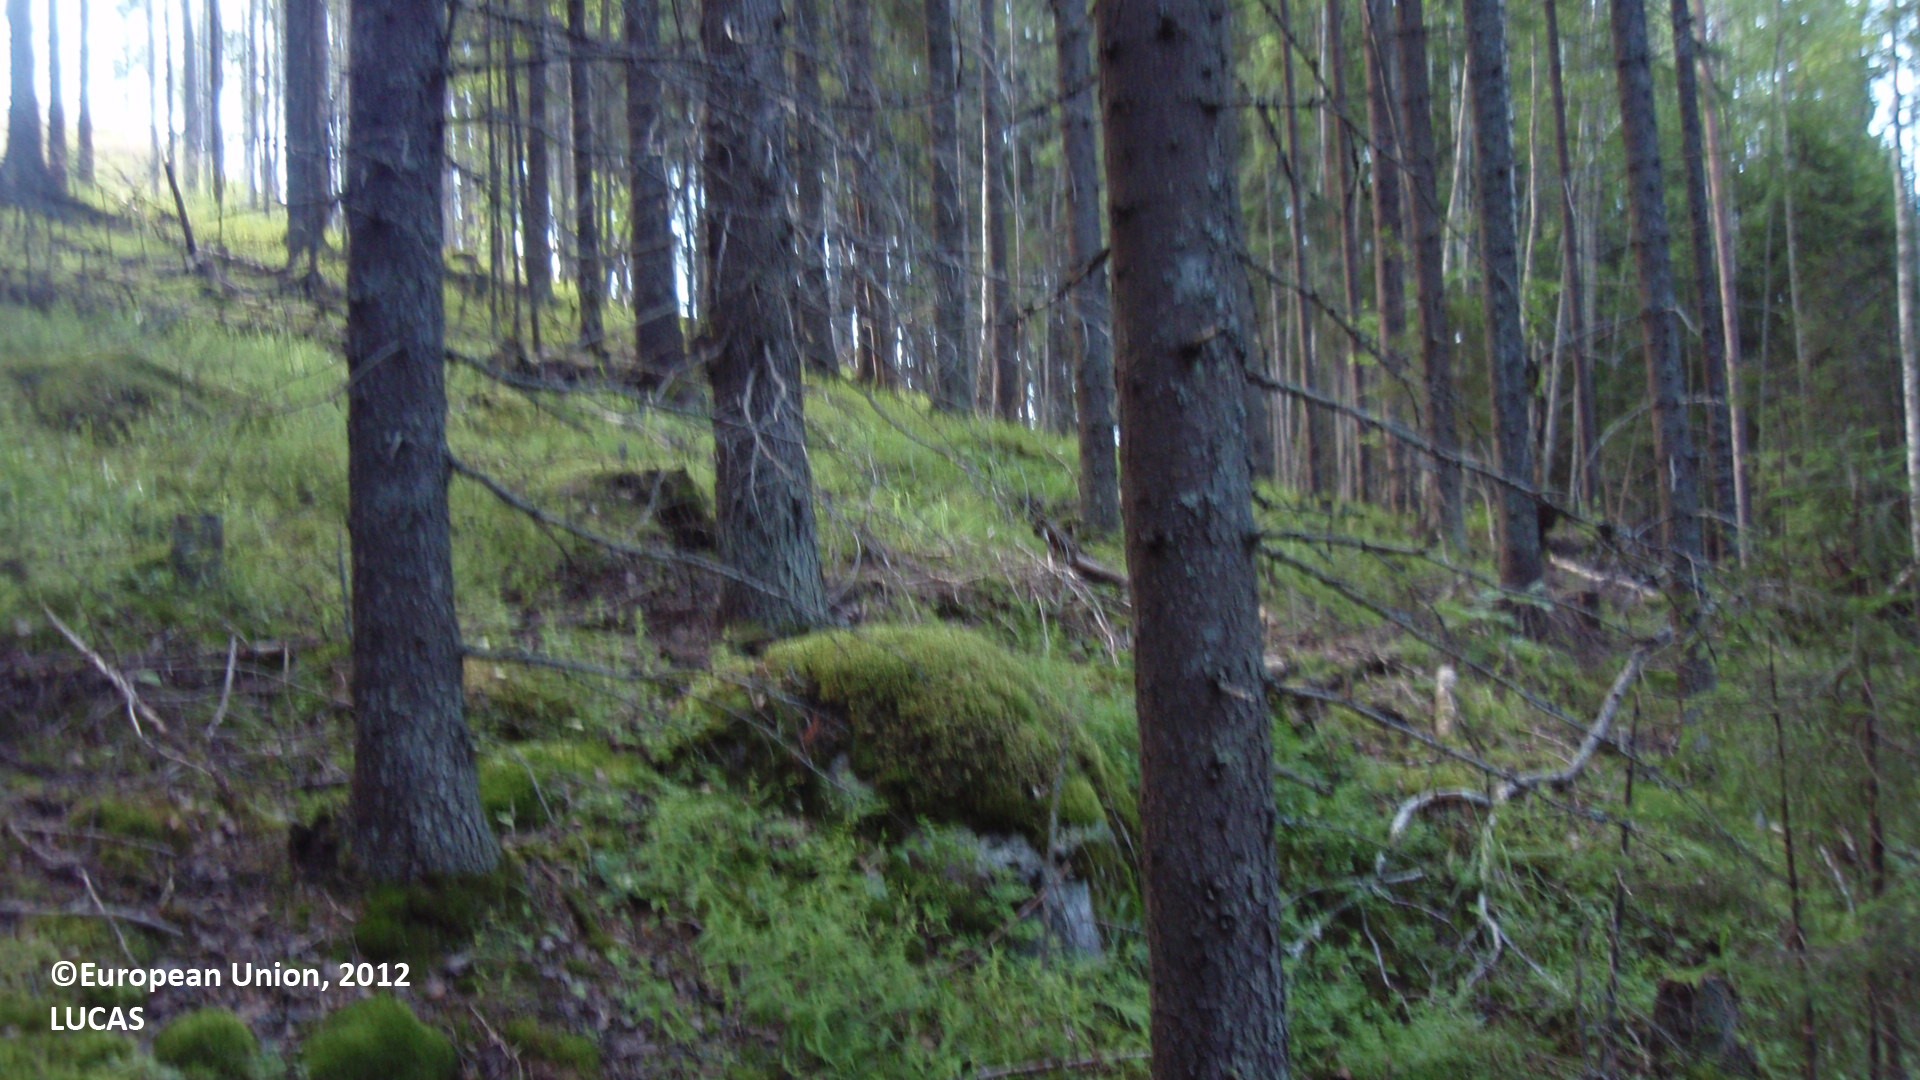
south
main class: Woodland
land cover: Spruce dominated coniferous woodland
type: boreal forest
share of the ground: 50 - 75 %
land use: Forestry
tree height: > 5 m
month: July
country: FI
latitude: 61.5954
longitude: 28.0794
